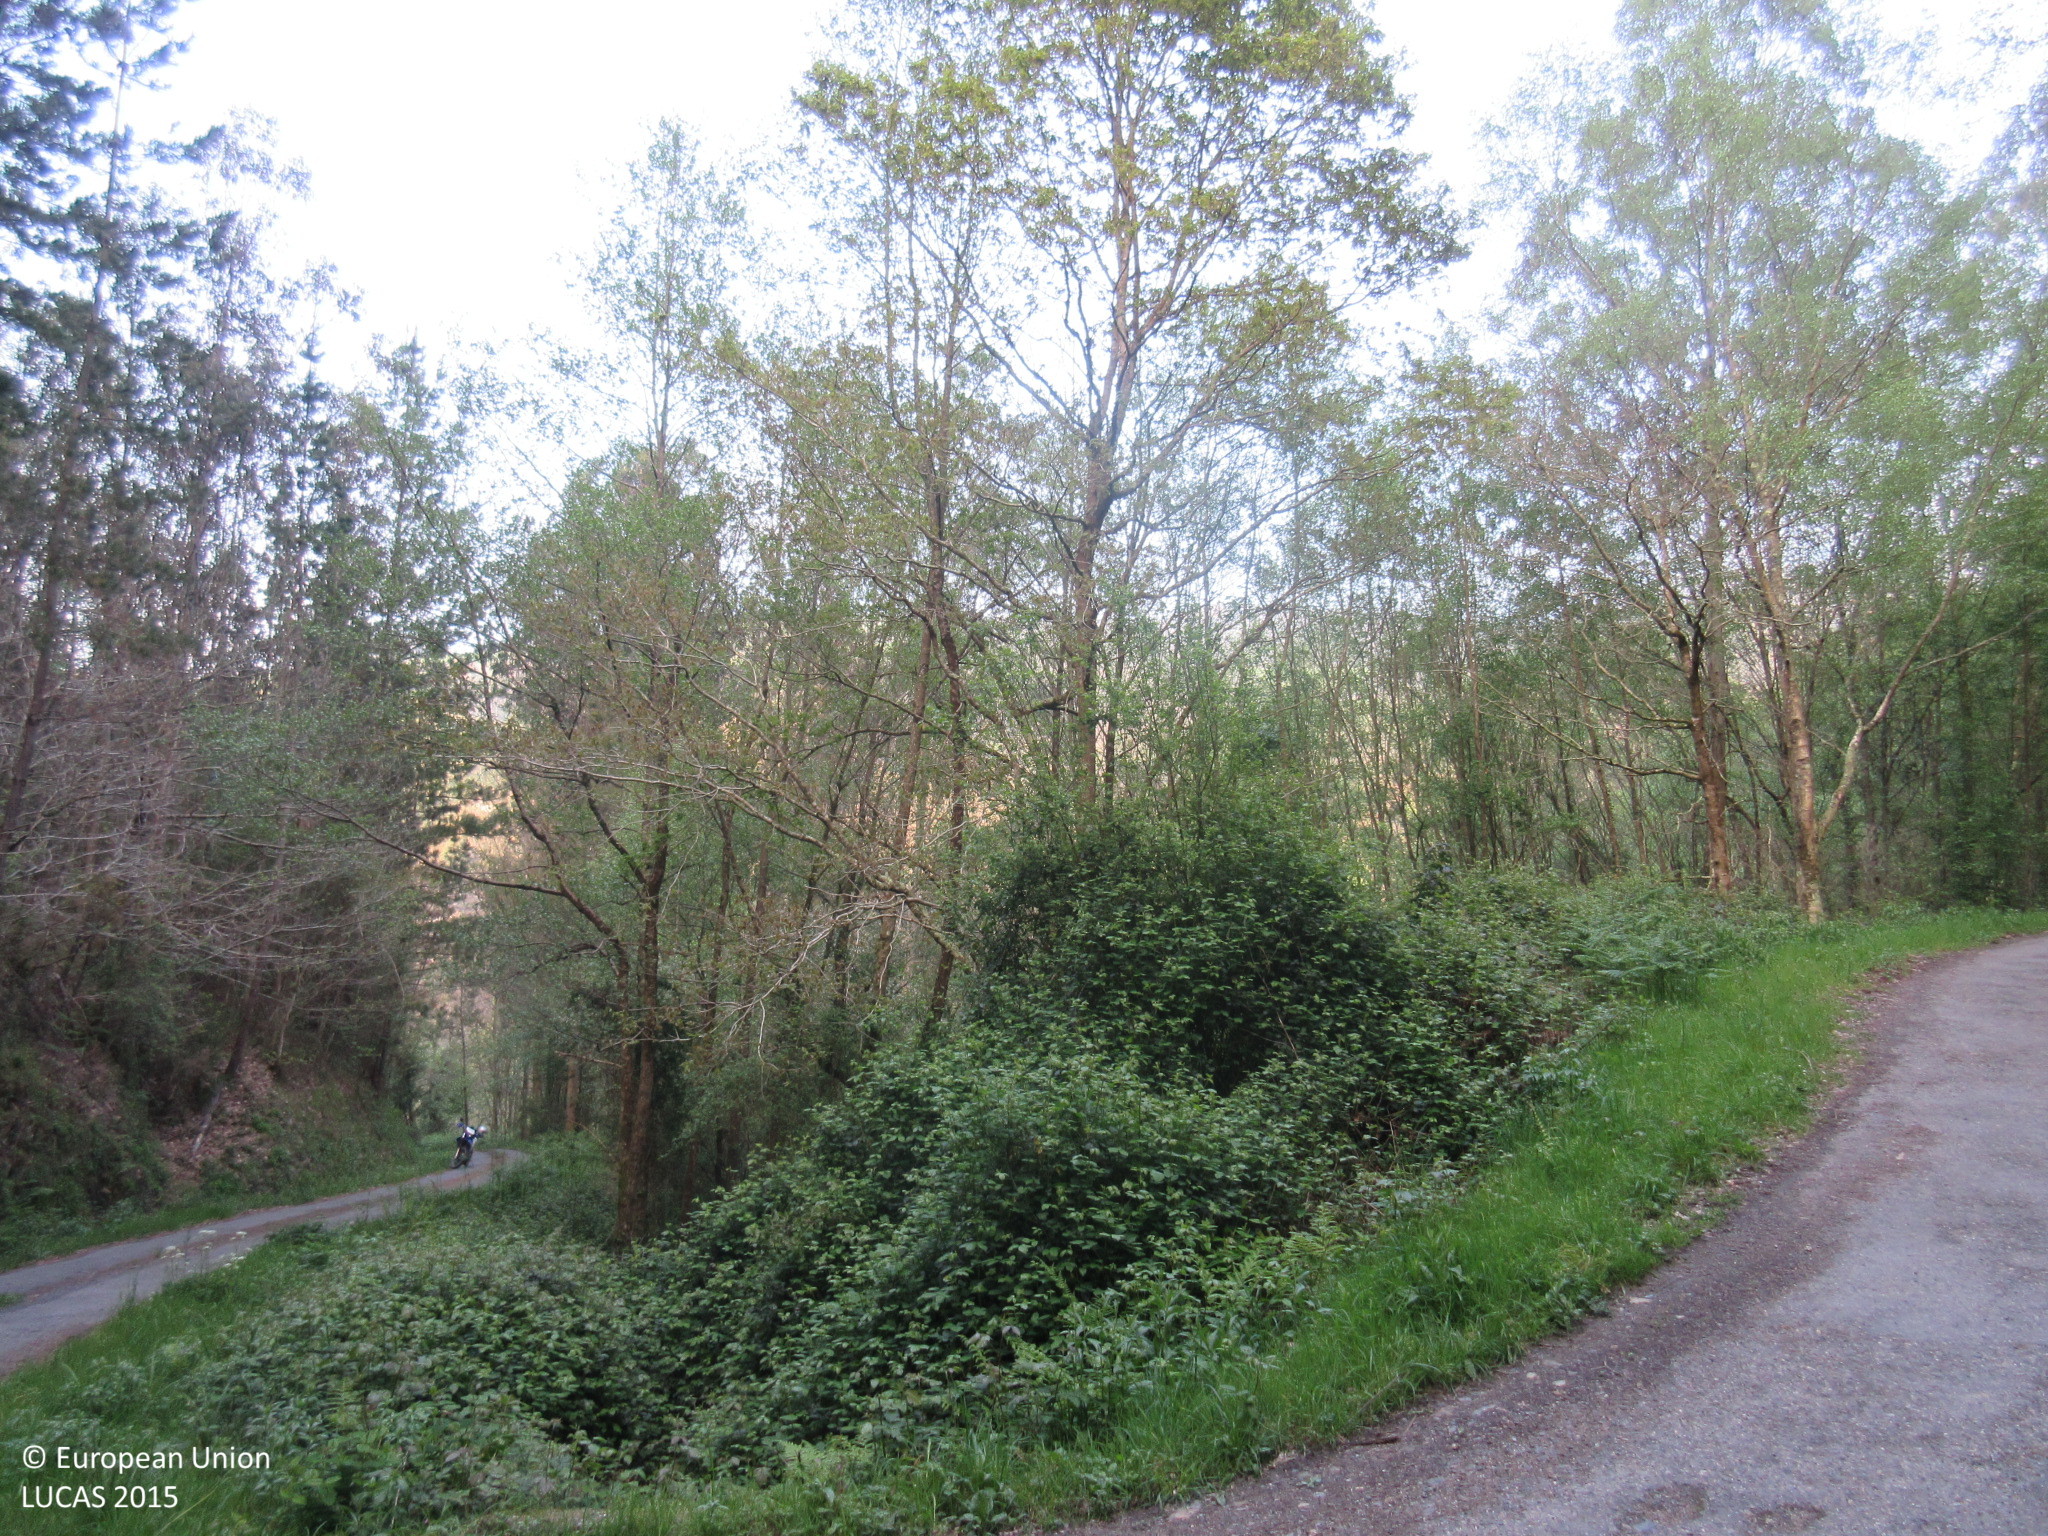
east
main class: Woodland
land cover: Broadleaved woodland
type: exotic forest
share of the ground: > 75 %
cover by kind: broadleaved forest trees 90 %, shrubs 10 %
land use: Forestry
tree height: > 5 m
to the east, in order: Broadleaved woodland; Grass margins; Paved roads, cycling and walking lanes; Grass margins; Broadleaved woodland
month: April
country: ES
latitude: 43.4139
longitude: -6.9987
